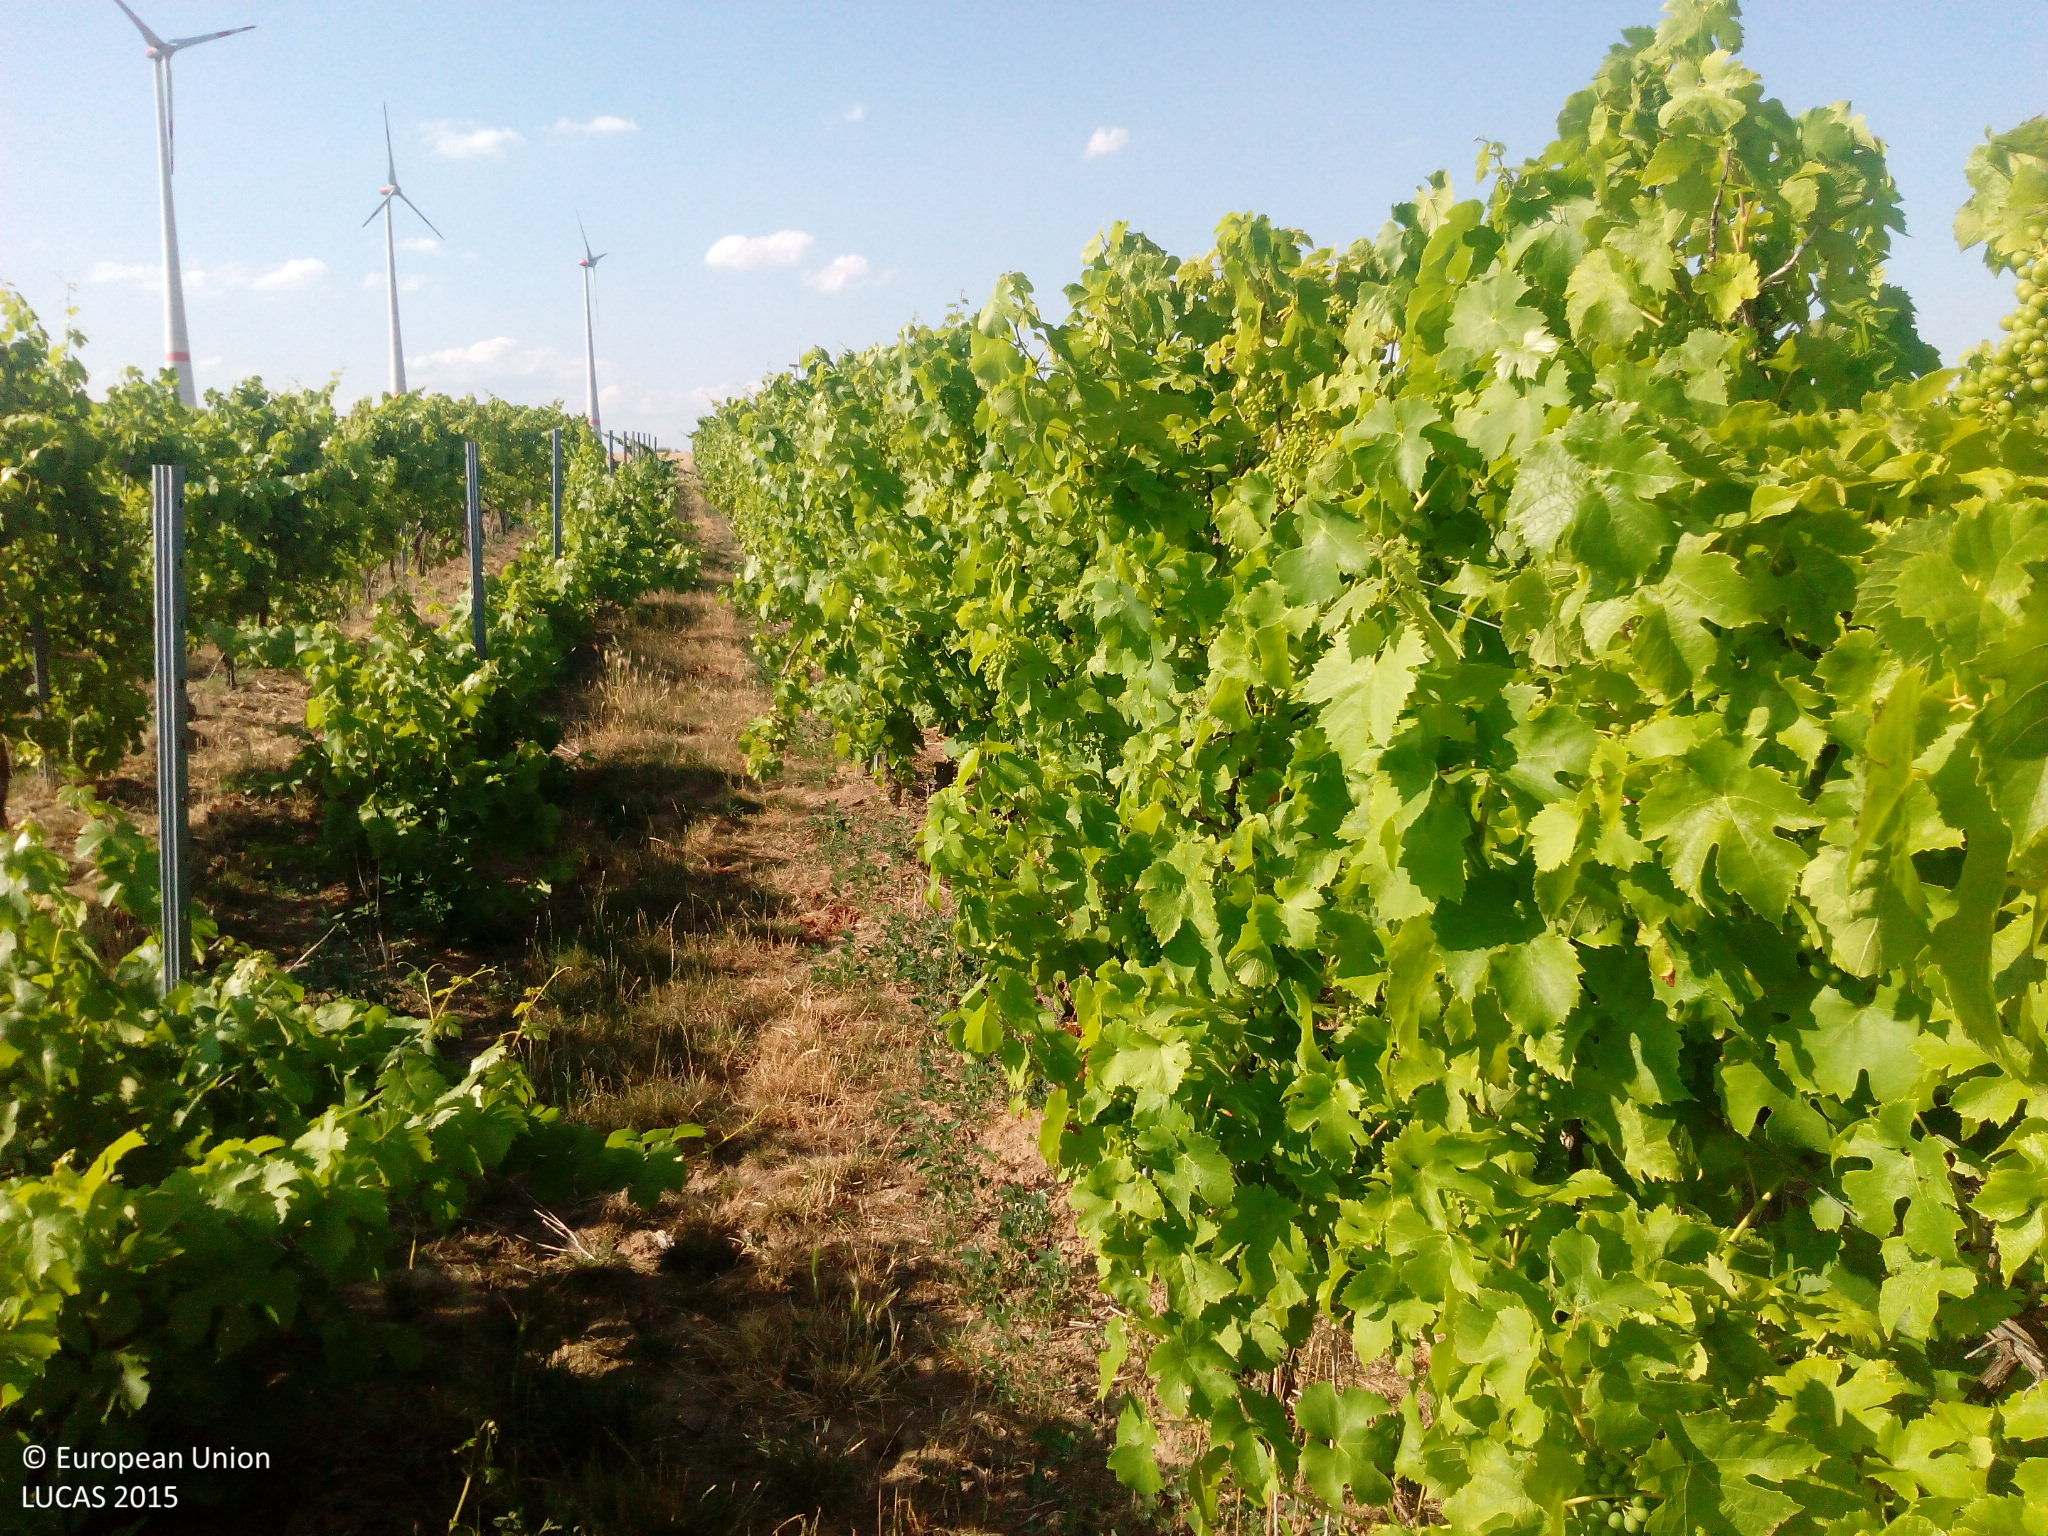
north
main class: Cropland
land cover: Vineyards
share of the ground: > 75 %
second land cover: Grassland without tree/shrub cover
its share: 50 - 75 %
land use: Agriculture (excluding fallow land and kitchen gardens)
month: July
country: DE
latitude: 49.8275
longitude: 8.1516
